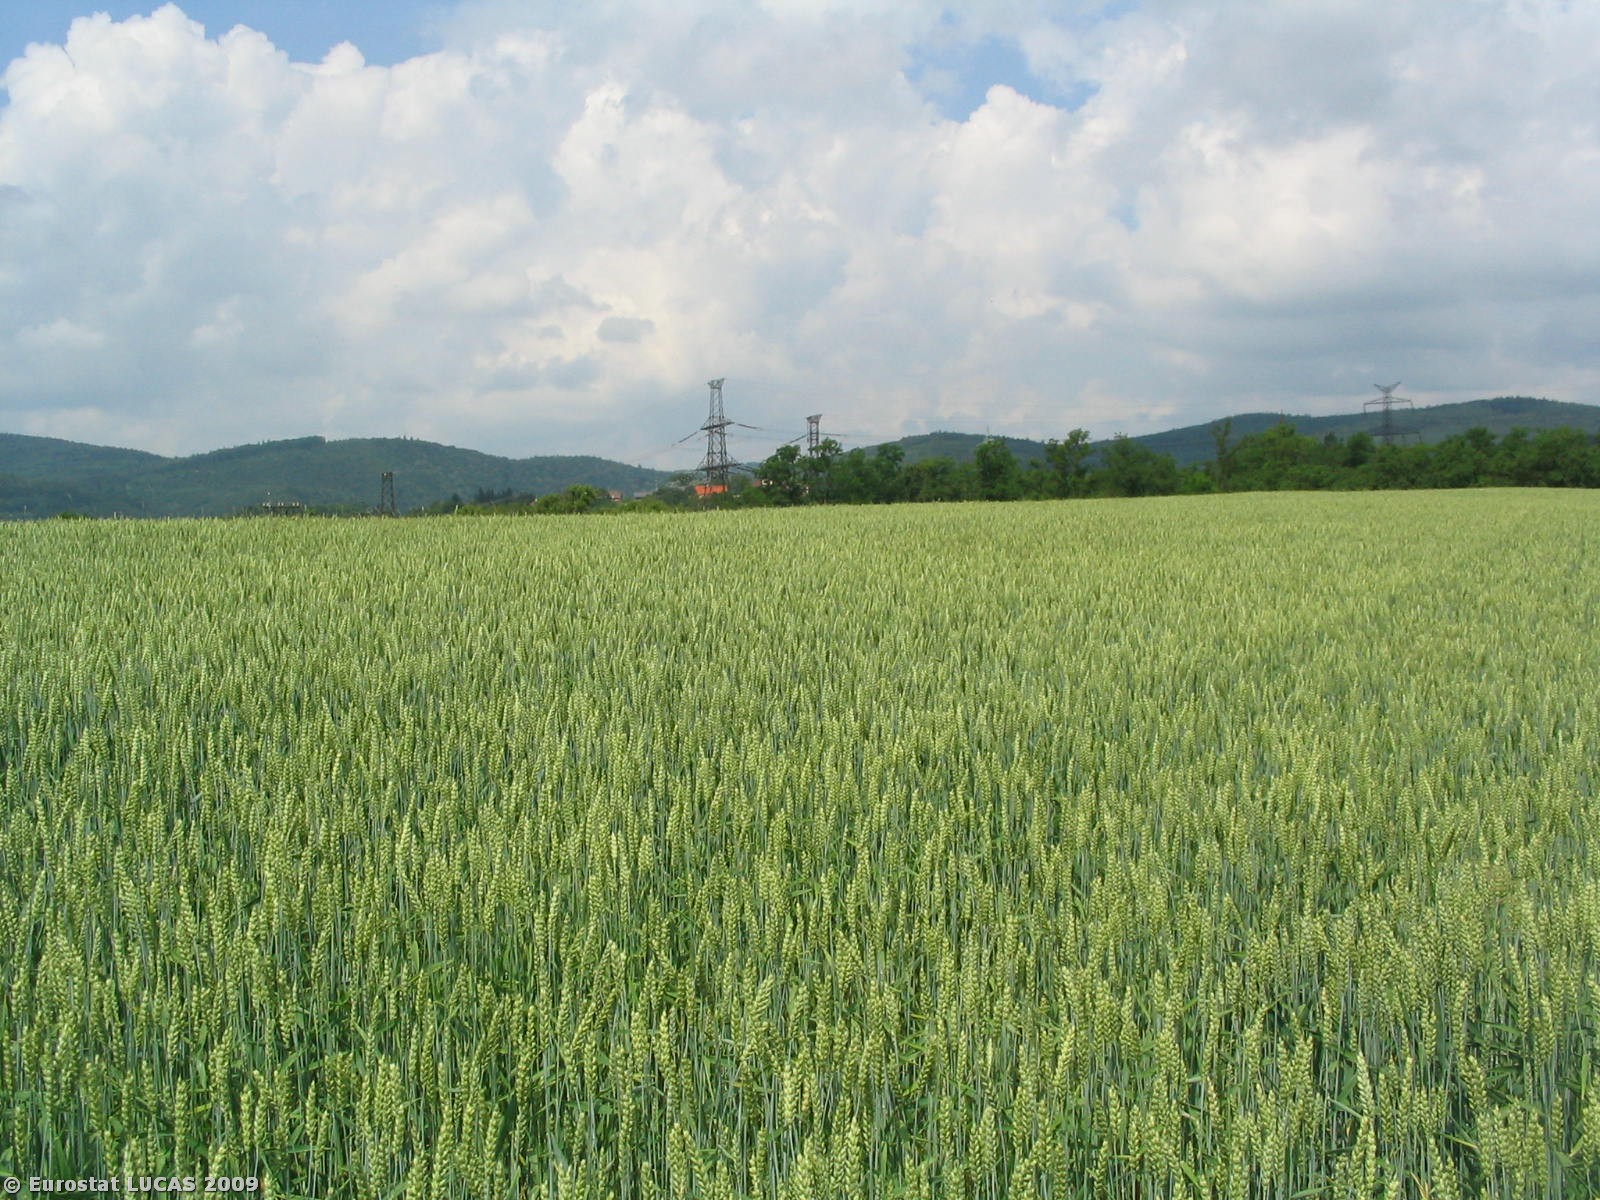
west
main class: Cropland
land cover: Common wheat
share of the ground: > 75 %
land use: Agriculture (excluding fallow land and kitchen gardens)
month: June
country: CZ
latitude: 49.2797
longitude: 16.4538
